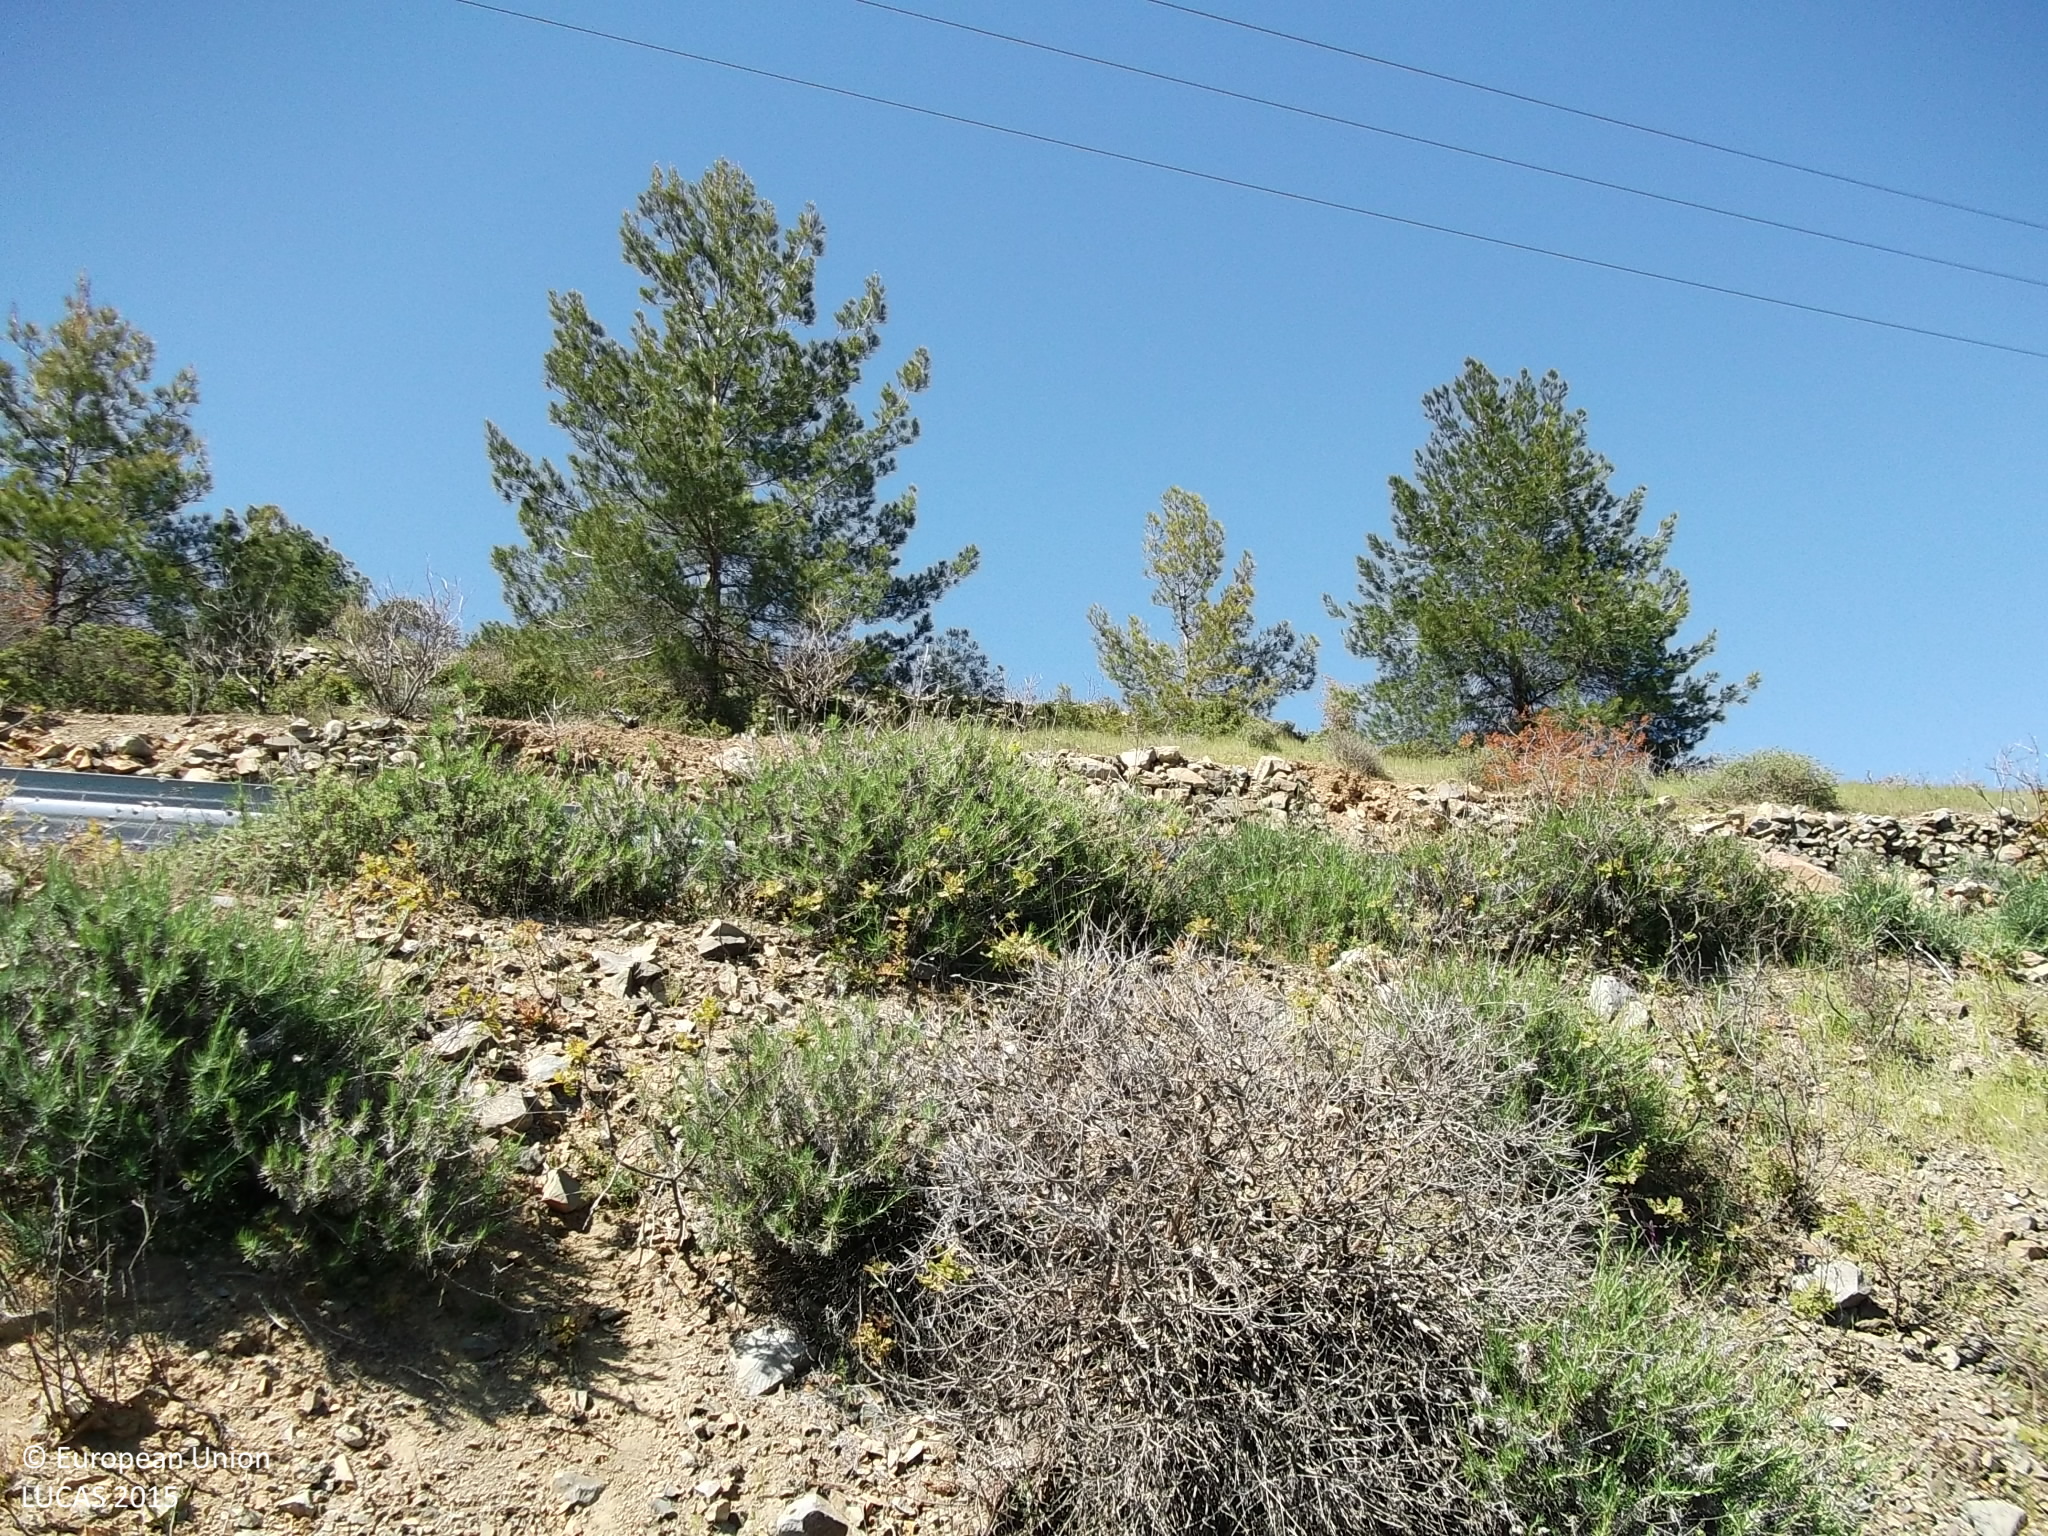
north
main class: Woodland
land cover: Pine dominated coniferous woodland
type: coniferous forest of the mediterranean region
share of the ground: 10 - 25 %
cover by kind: shrubs 65 %, coniferous forest trees 20 %, consolidated bare surface 10 %, unconsolidated bare surface 5 %
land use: Forestry
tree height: > 5 m
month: April
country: CY
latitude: 34.9005
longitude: 33.1695
